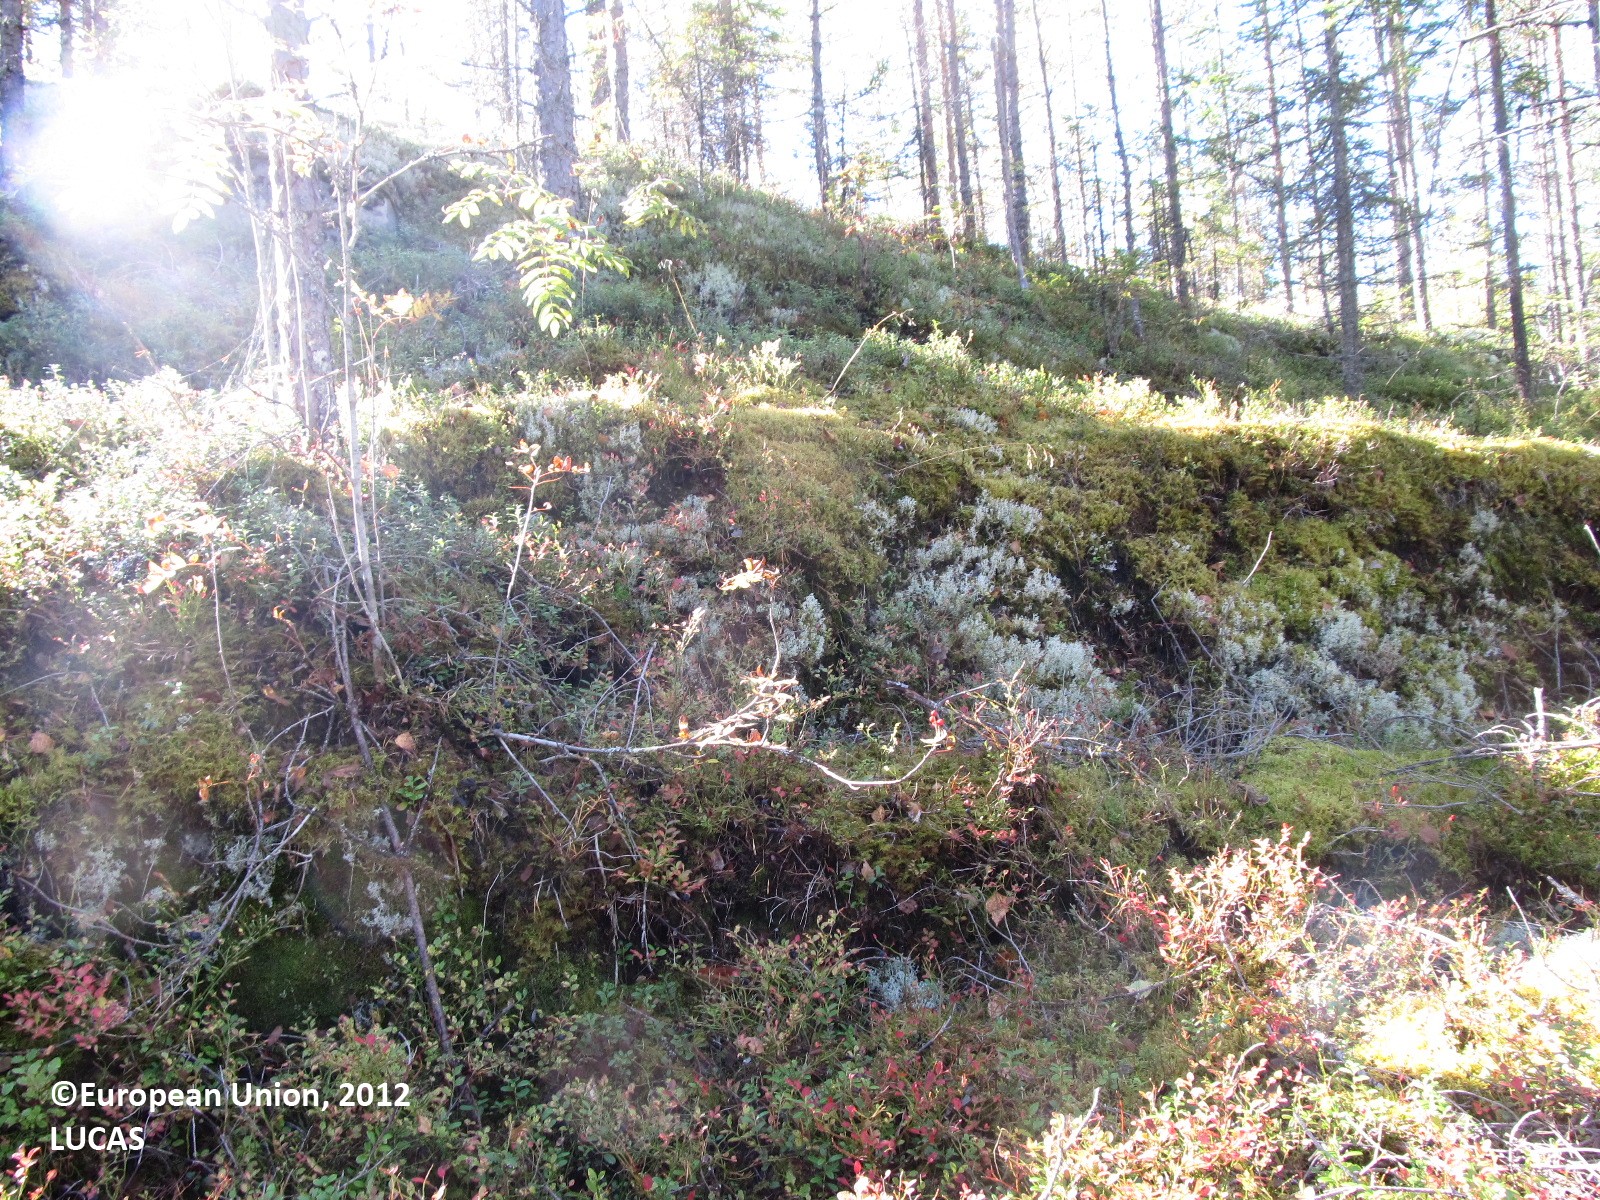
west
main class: Woodland
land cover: Other coniferous woodland
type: boreal forest
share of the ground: 50 - 75 %
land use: Forestry
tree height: > 5 m
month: September
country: FI
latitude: 62.4478
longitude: 28.5554
